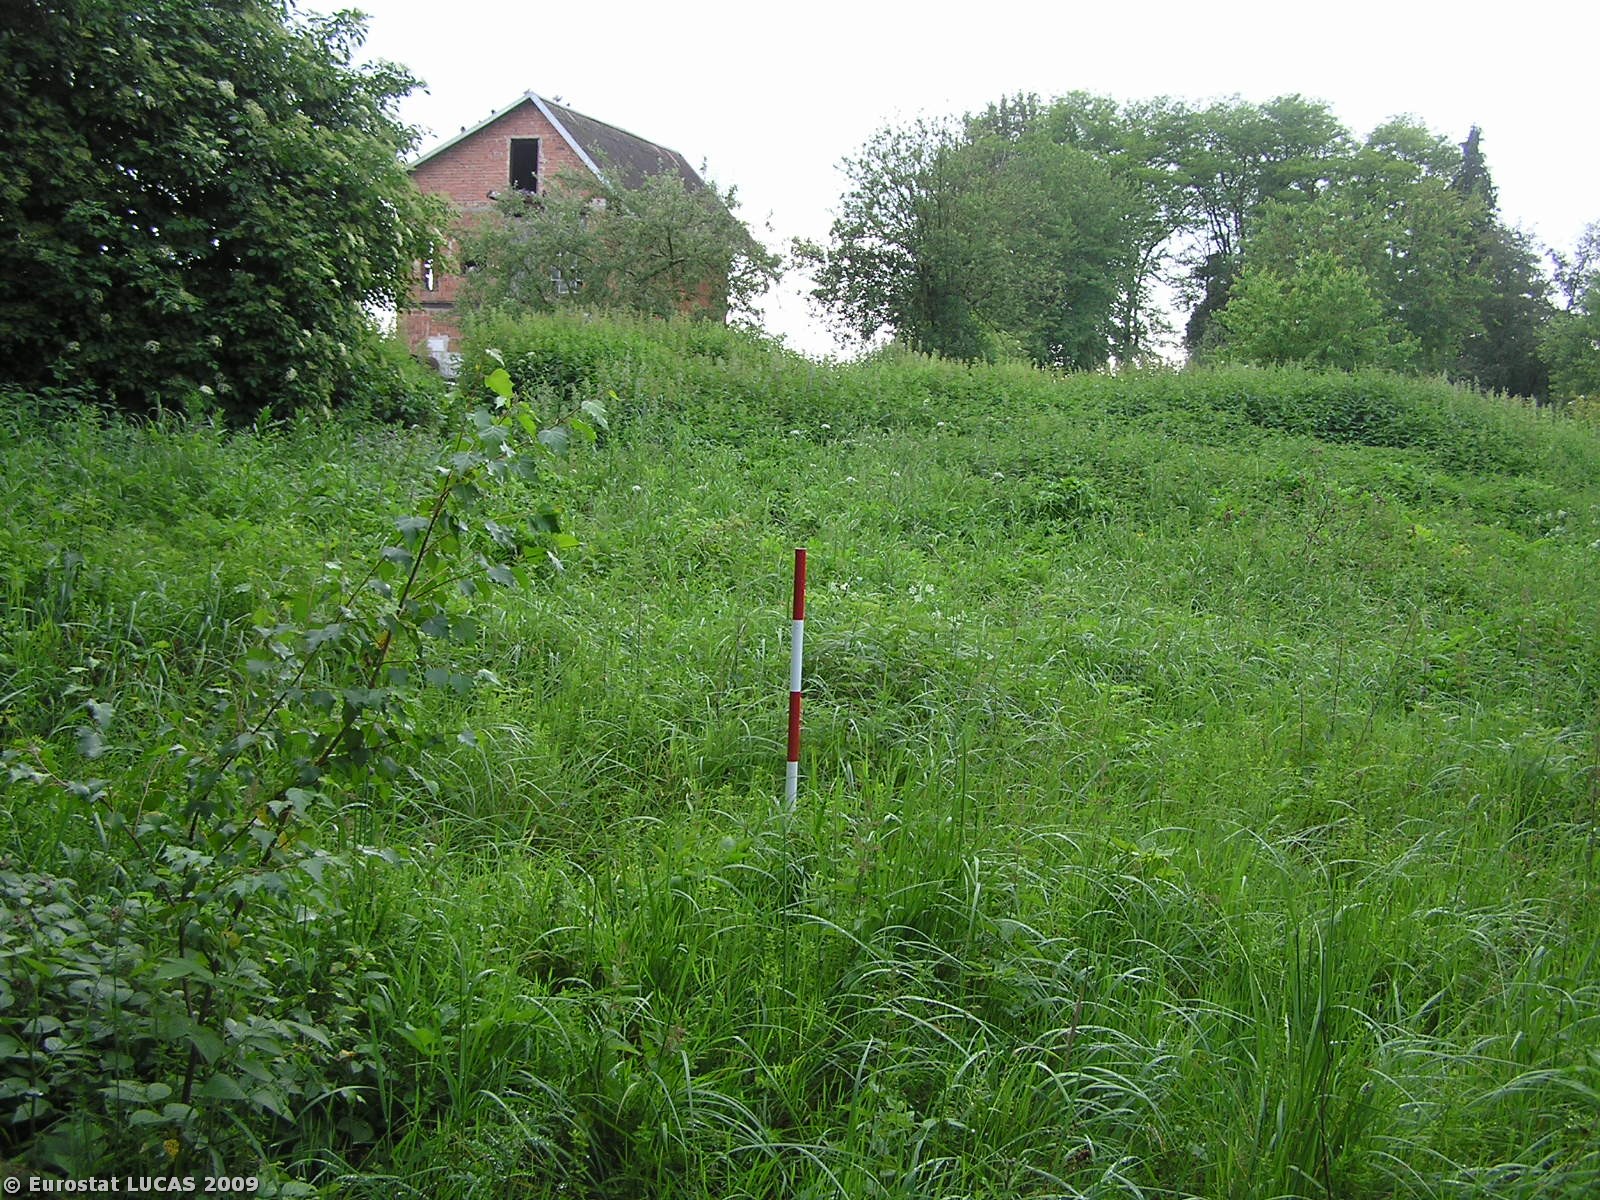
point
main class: Grassland
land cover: Grassland without tree/shrub cover
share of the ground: > 75 %
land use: Unused
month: June
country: CZ
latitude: 49.6445
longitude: 14.9465
